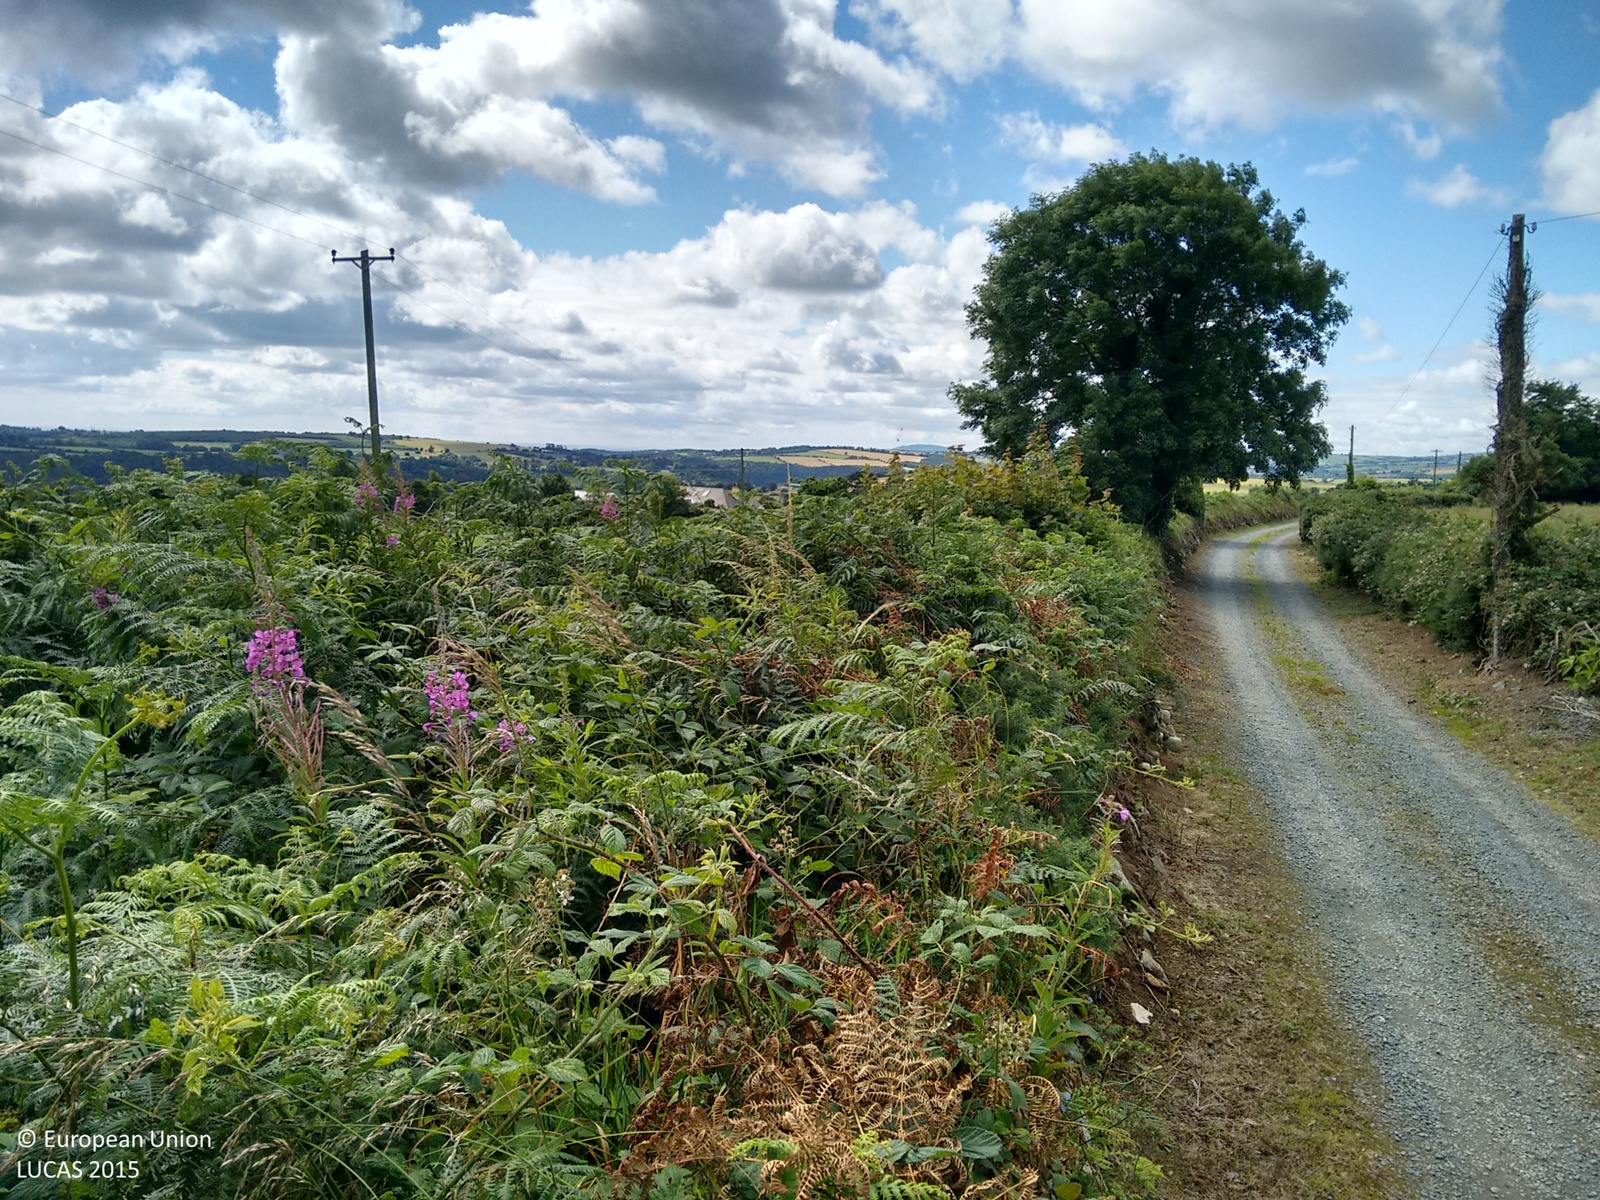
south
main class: Grassland
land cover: Grassland without tree/shrub cover
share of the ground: > 75 %
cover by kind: herbaceous plants 100 %
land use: Agriculture (excluding fallow land and kitchen gardens)
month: July
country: IE
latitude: 52.8646
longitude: -6.2366
